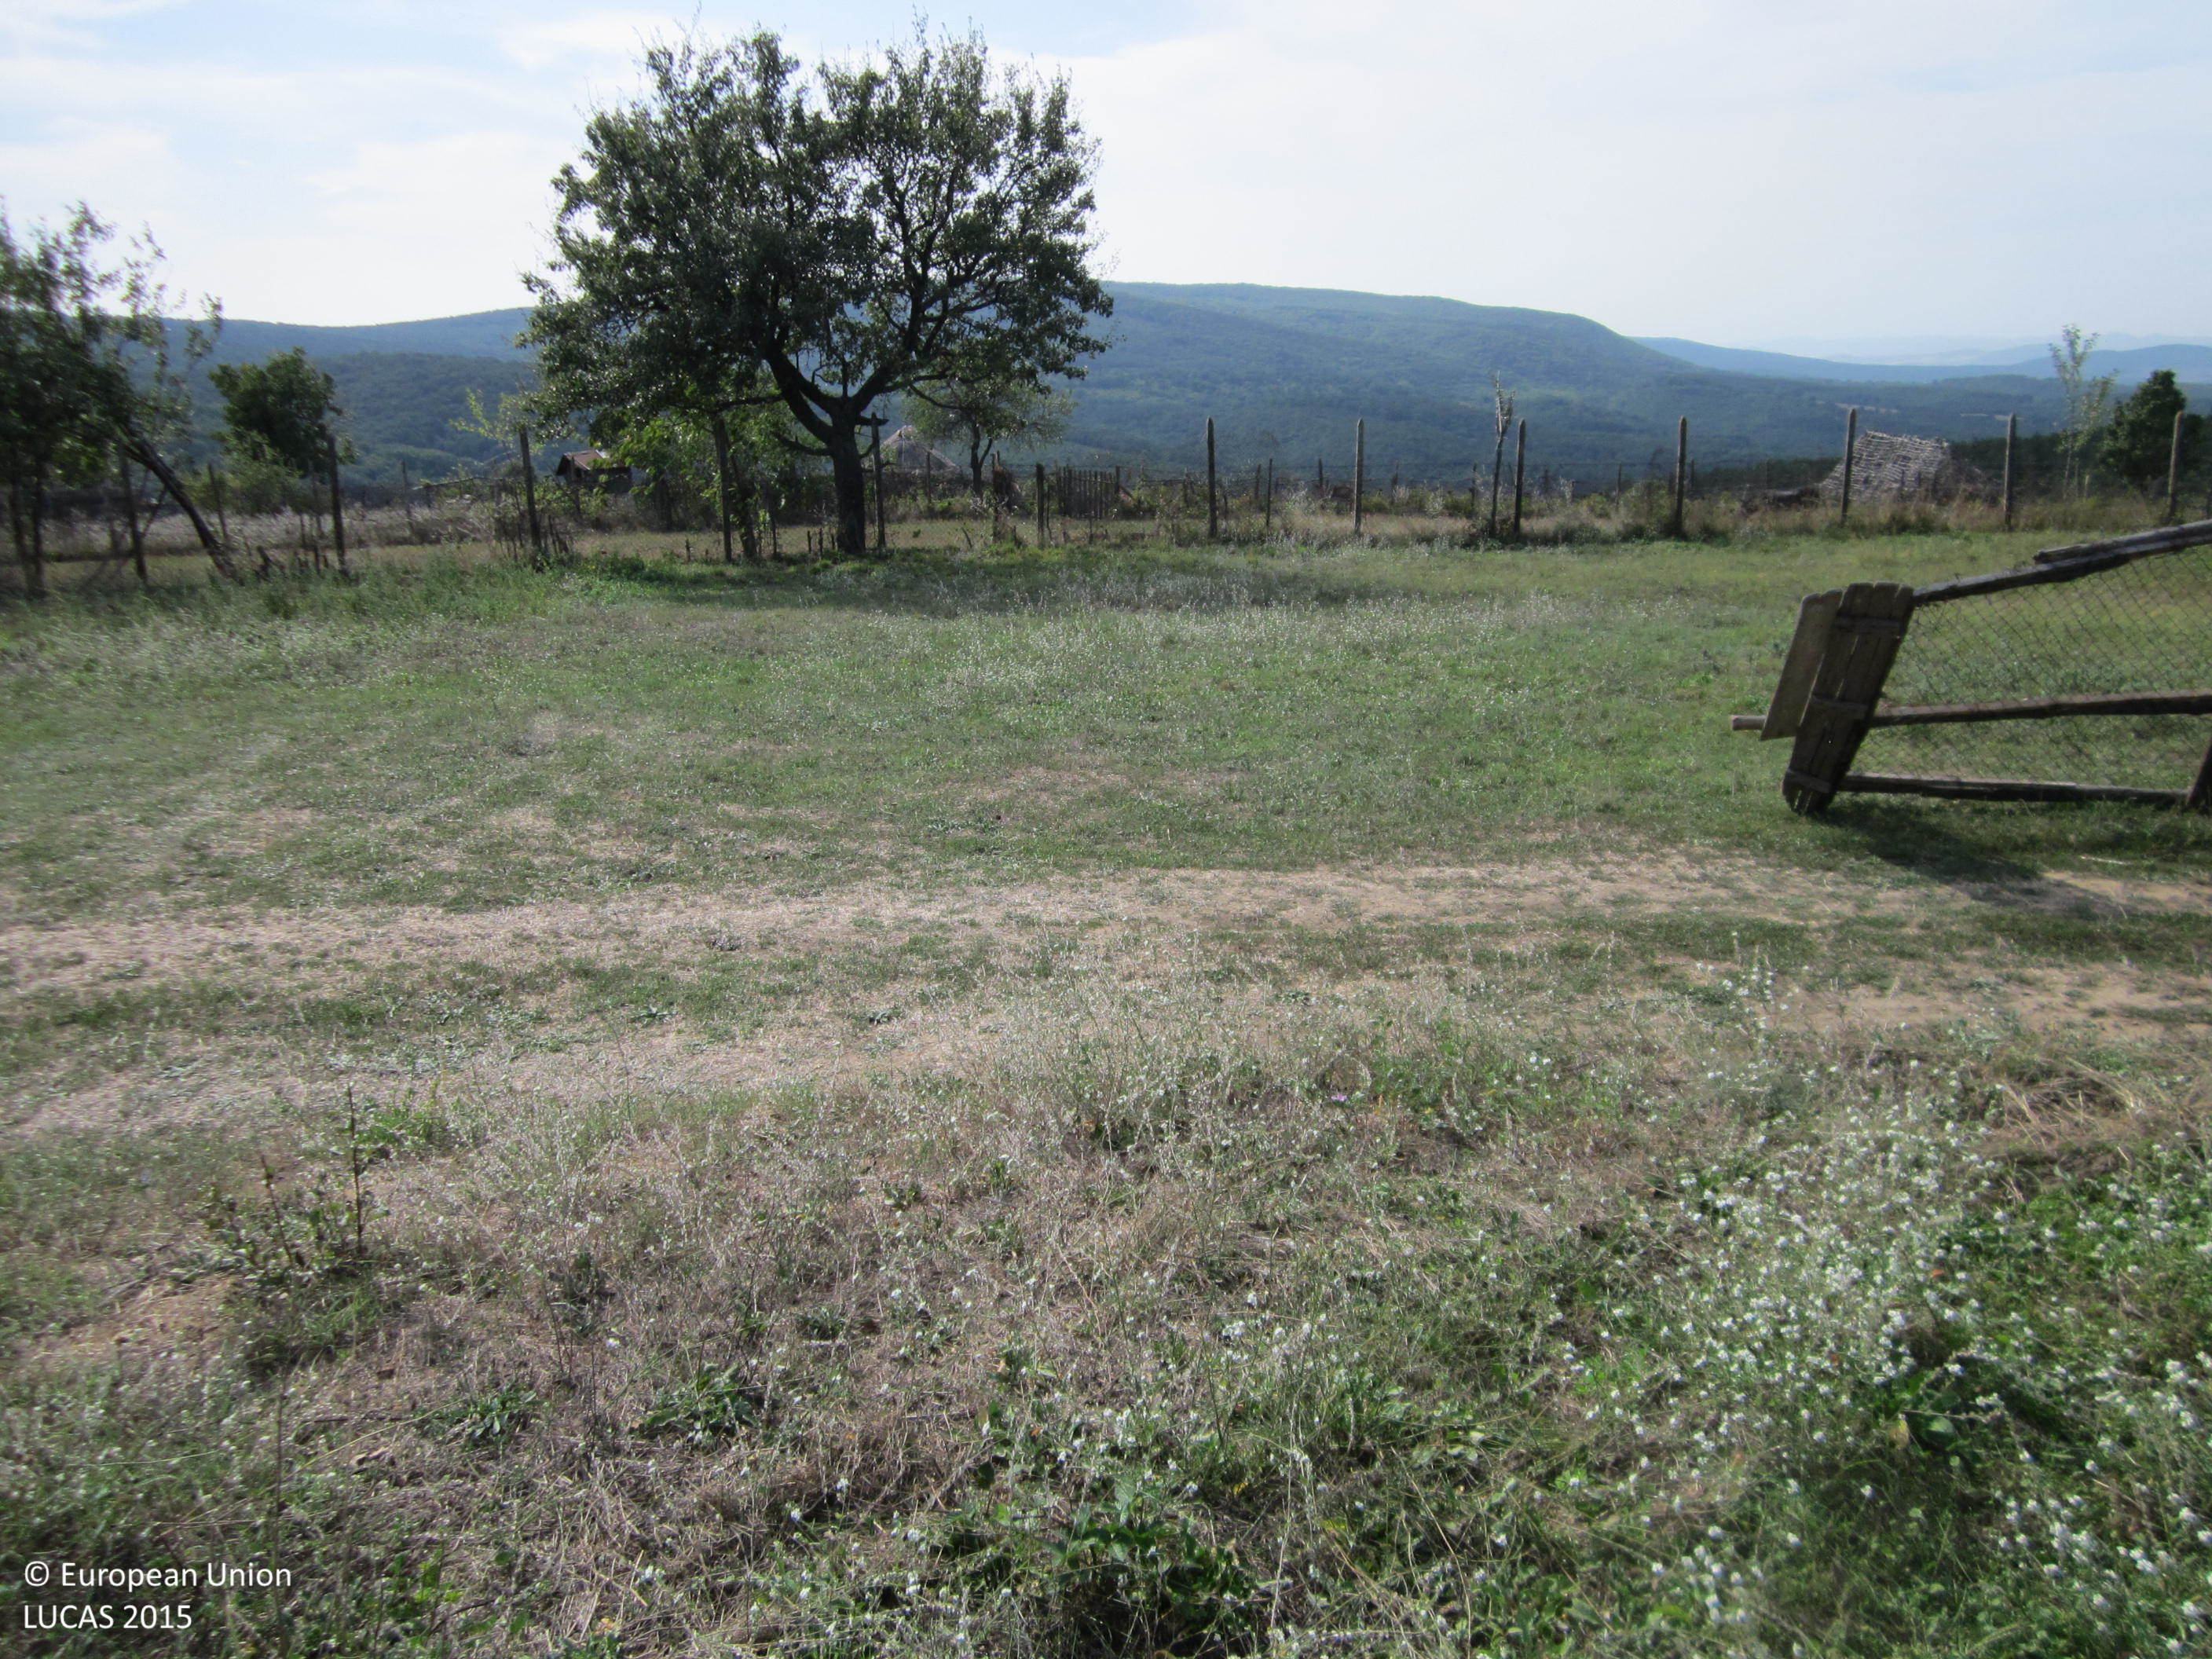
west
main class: Cropland
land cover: Potatoes
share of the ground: 25 - 50 %
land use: Kitchen garden
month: September
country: BG
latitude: 42.7785
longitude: 27.1635
